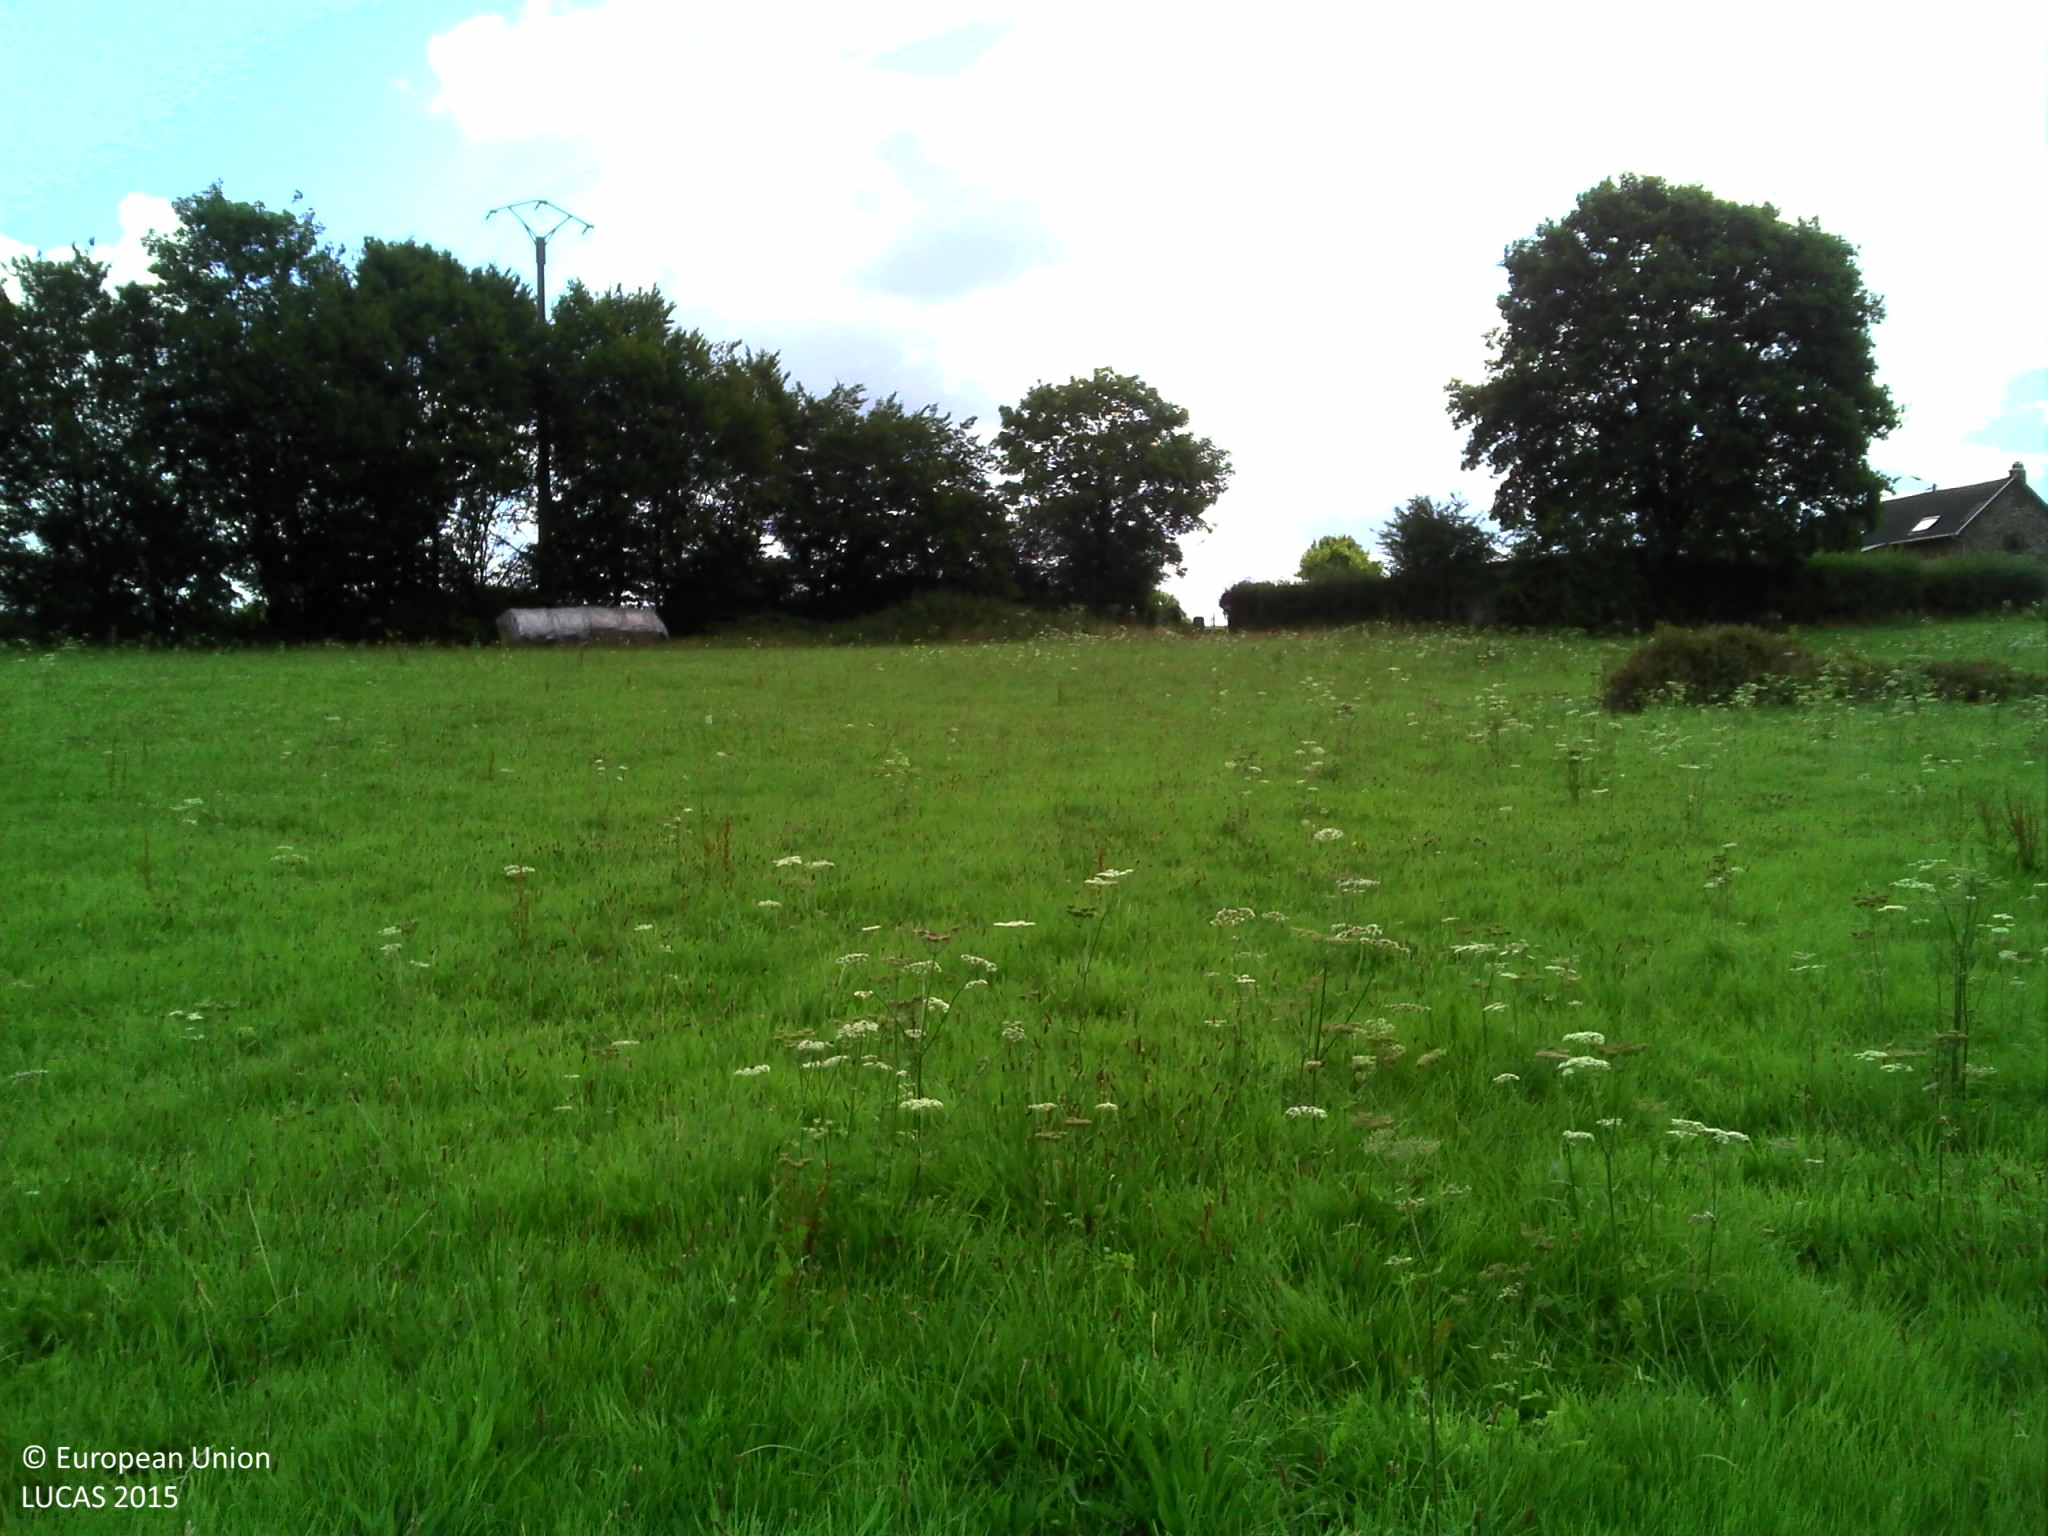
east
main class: Grassland
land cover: Grassland without tree/shrub cover
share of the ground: > 75 %
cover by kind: herbaceous plants 100 %
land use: Agriculture (excluding fallow land and kitchen gardens)
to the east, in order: Grassland without tree/shrub cover; Electric lines; Grassland without tree/shrub cover; Broadleaved woodland; Fences; Grassland without tree/shrub cover
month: July
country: BE
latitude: 50.0173
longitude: 4.1753
